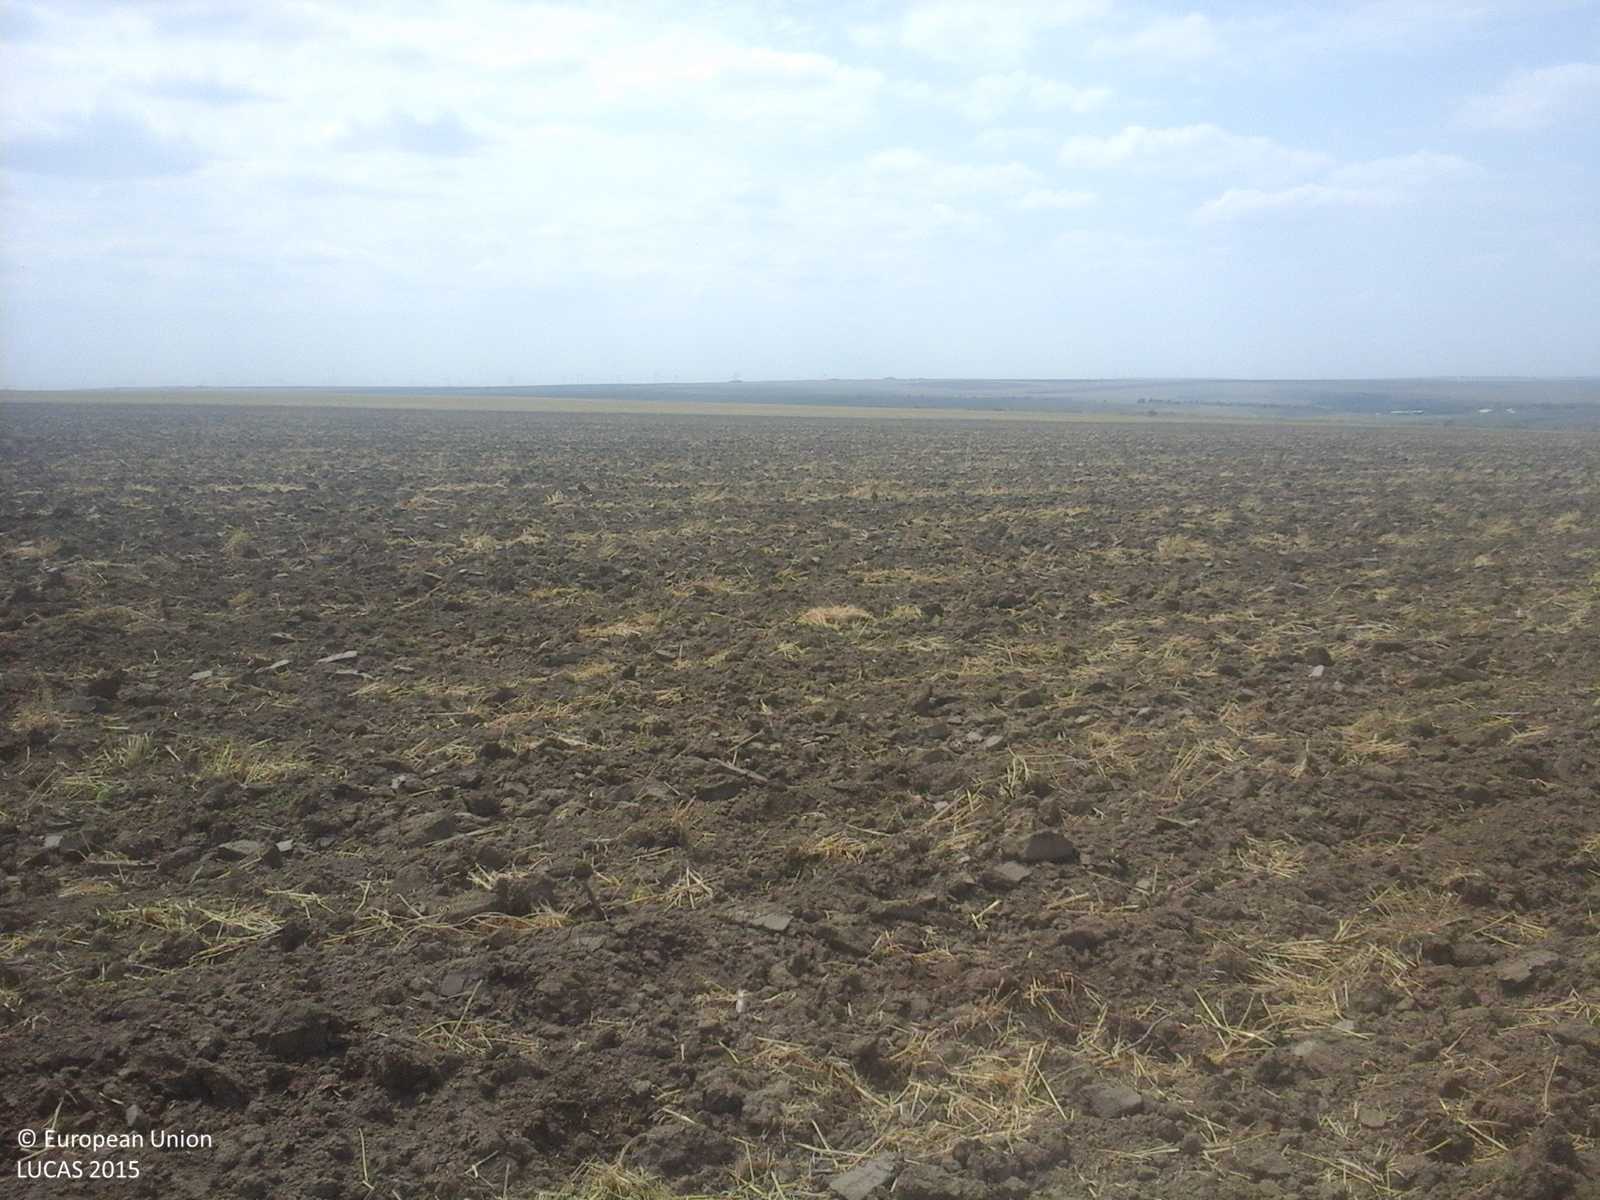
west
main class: Cropland
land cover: Common wheat
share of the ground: < 10 %
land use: Agriculture (excluding fallow land and kitchen gardens)
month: August
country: RO
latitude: 44.7030
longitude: 28.2799
